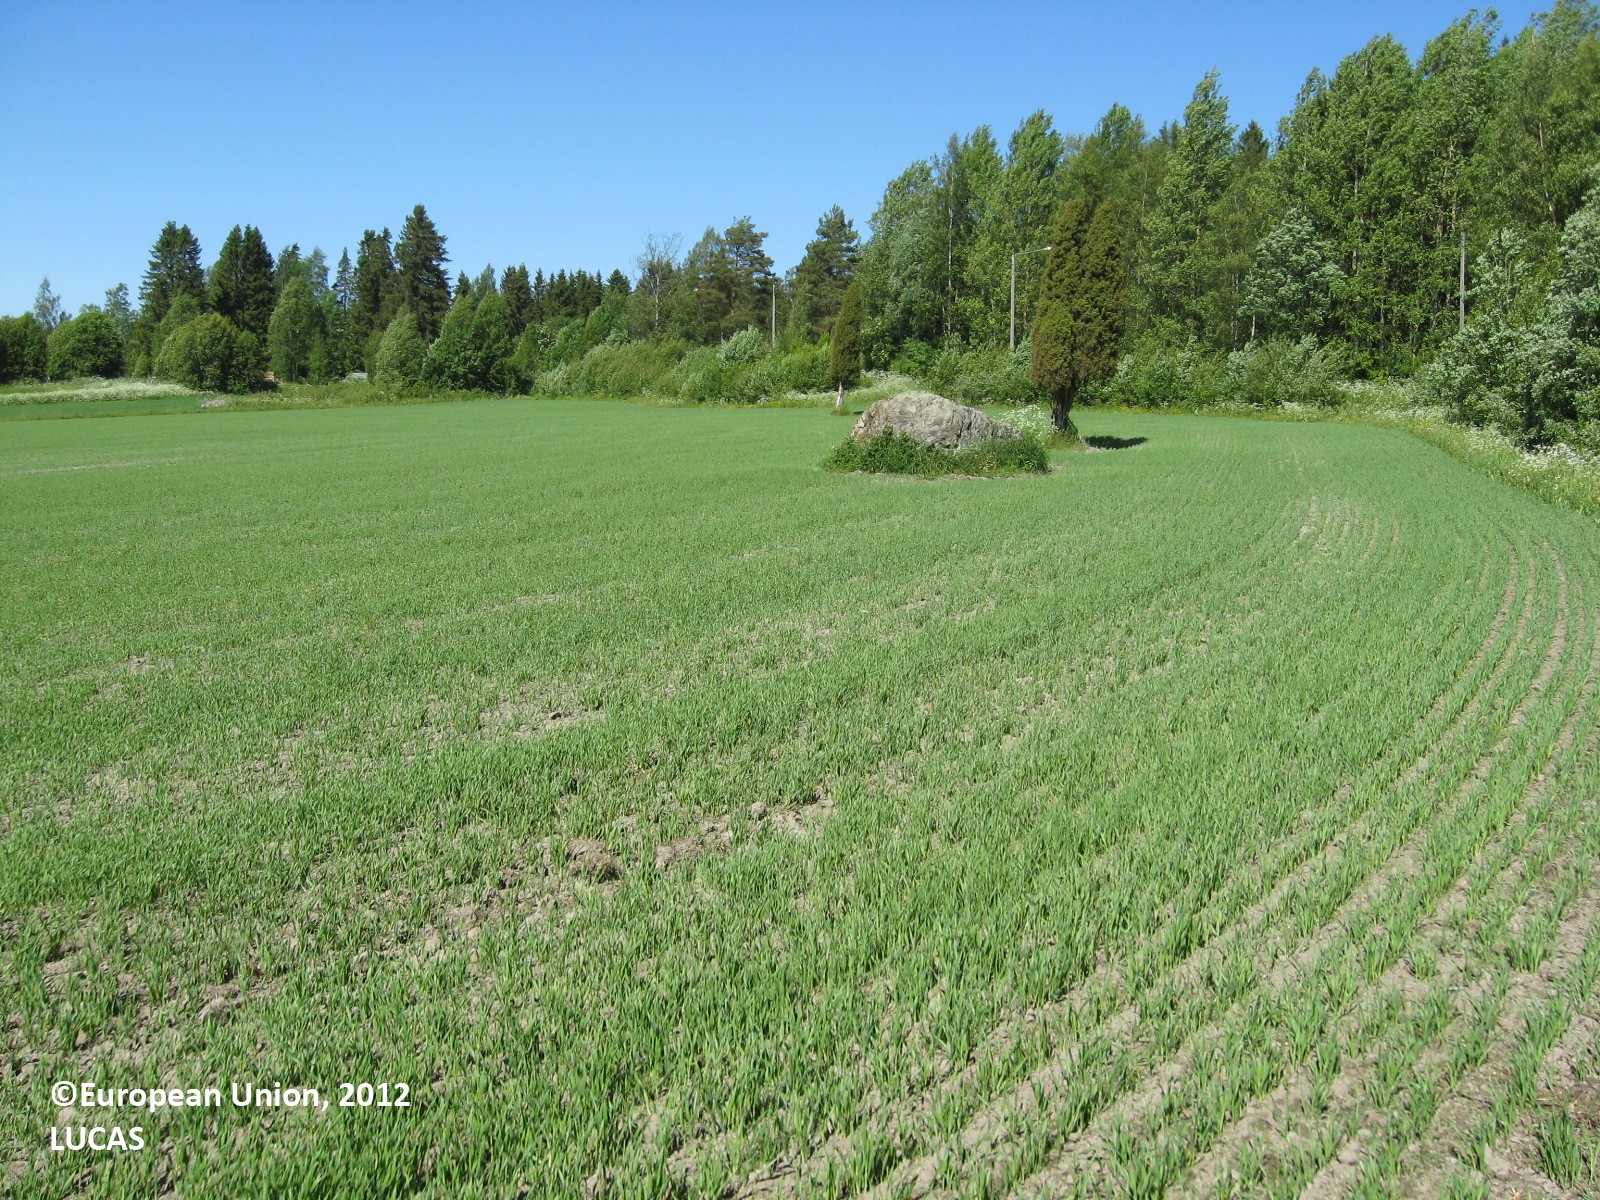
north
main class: Cropland
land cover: Rye
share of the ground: 50 - 75 %
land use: Agriculture (excluding fallow land and kitchen gardens)
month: June
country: FI
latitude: 62.9529
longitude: 21.7715
